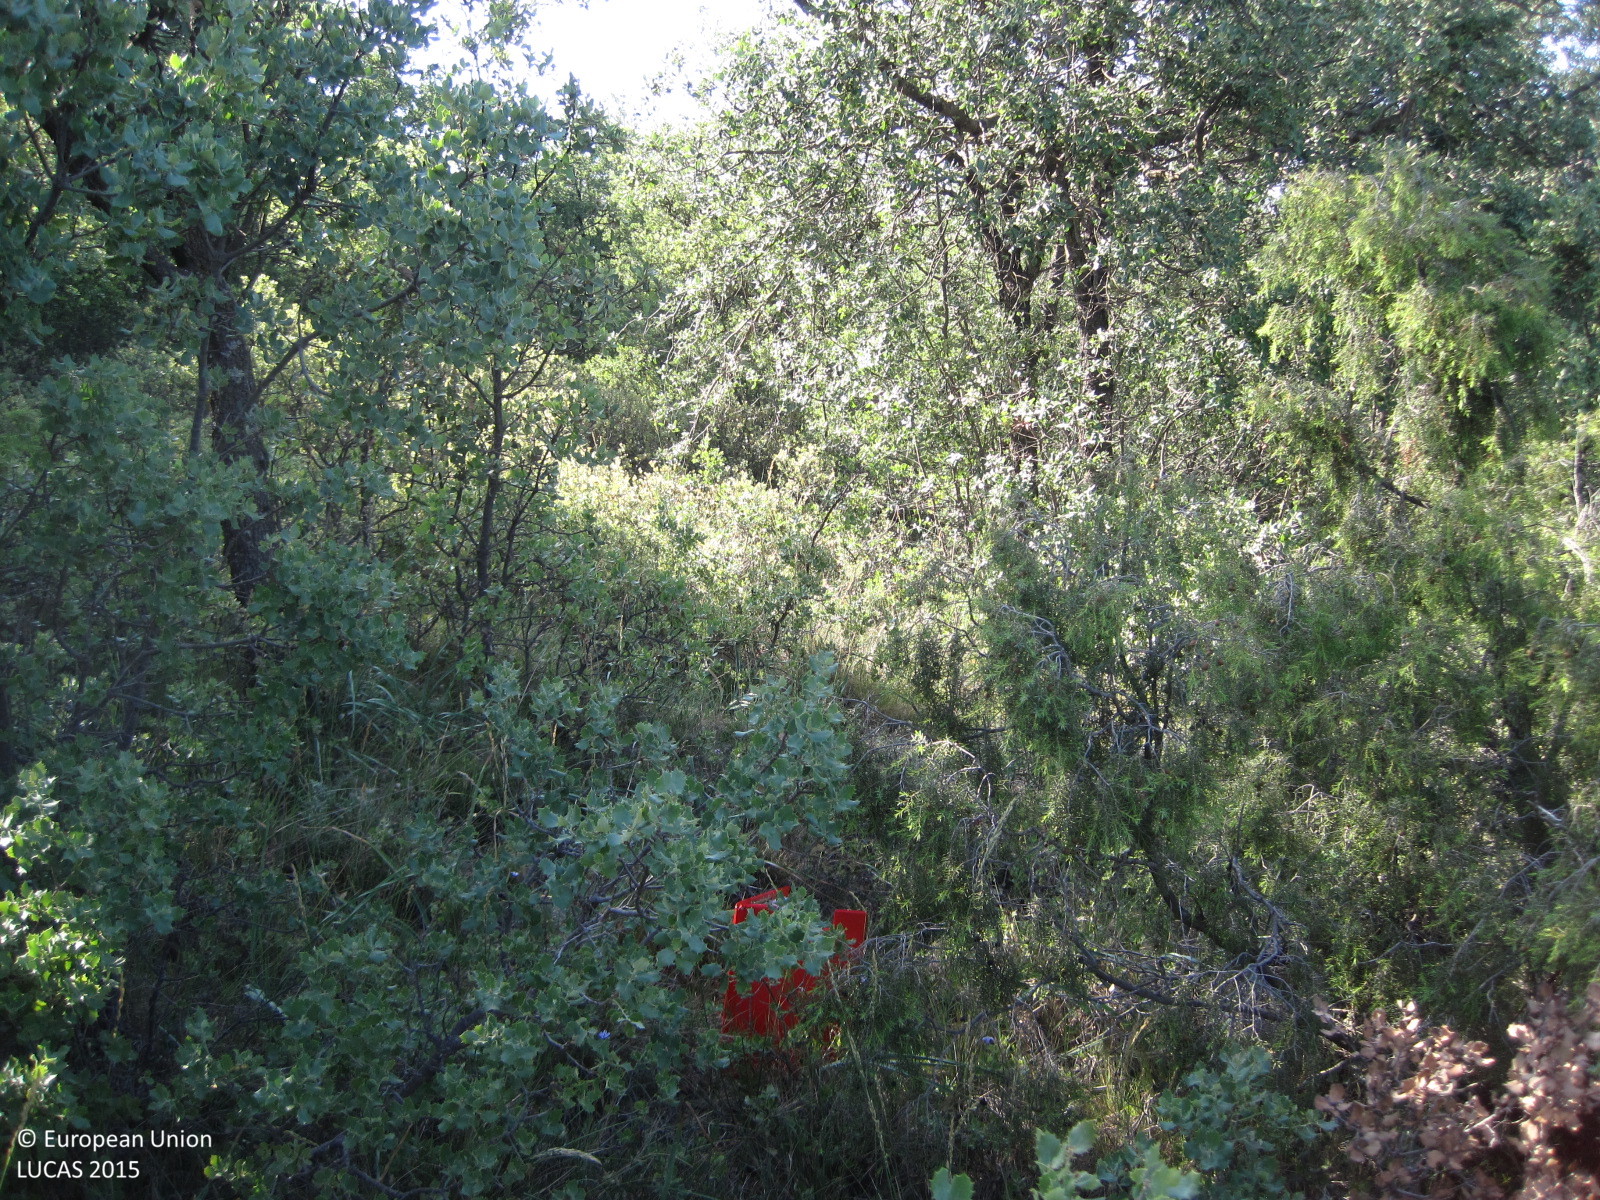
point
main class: Woodland
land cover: Broadleaved woodland
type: thermophilous deciduous forest
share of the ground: > 75 %
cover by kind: broadleaved forest trees 80 %, shrubs 15 %, coniferous forest trees 5 %
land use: Forestry
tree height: > 5 m
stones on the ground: 25 - 50 %
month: May
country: ES
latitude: 39.6320
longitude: -1.1298
